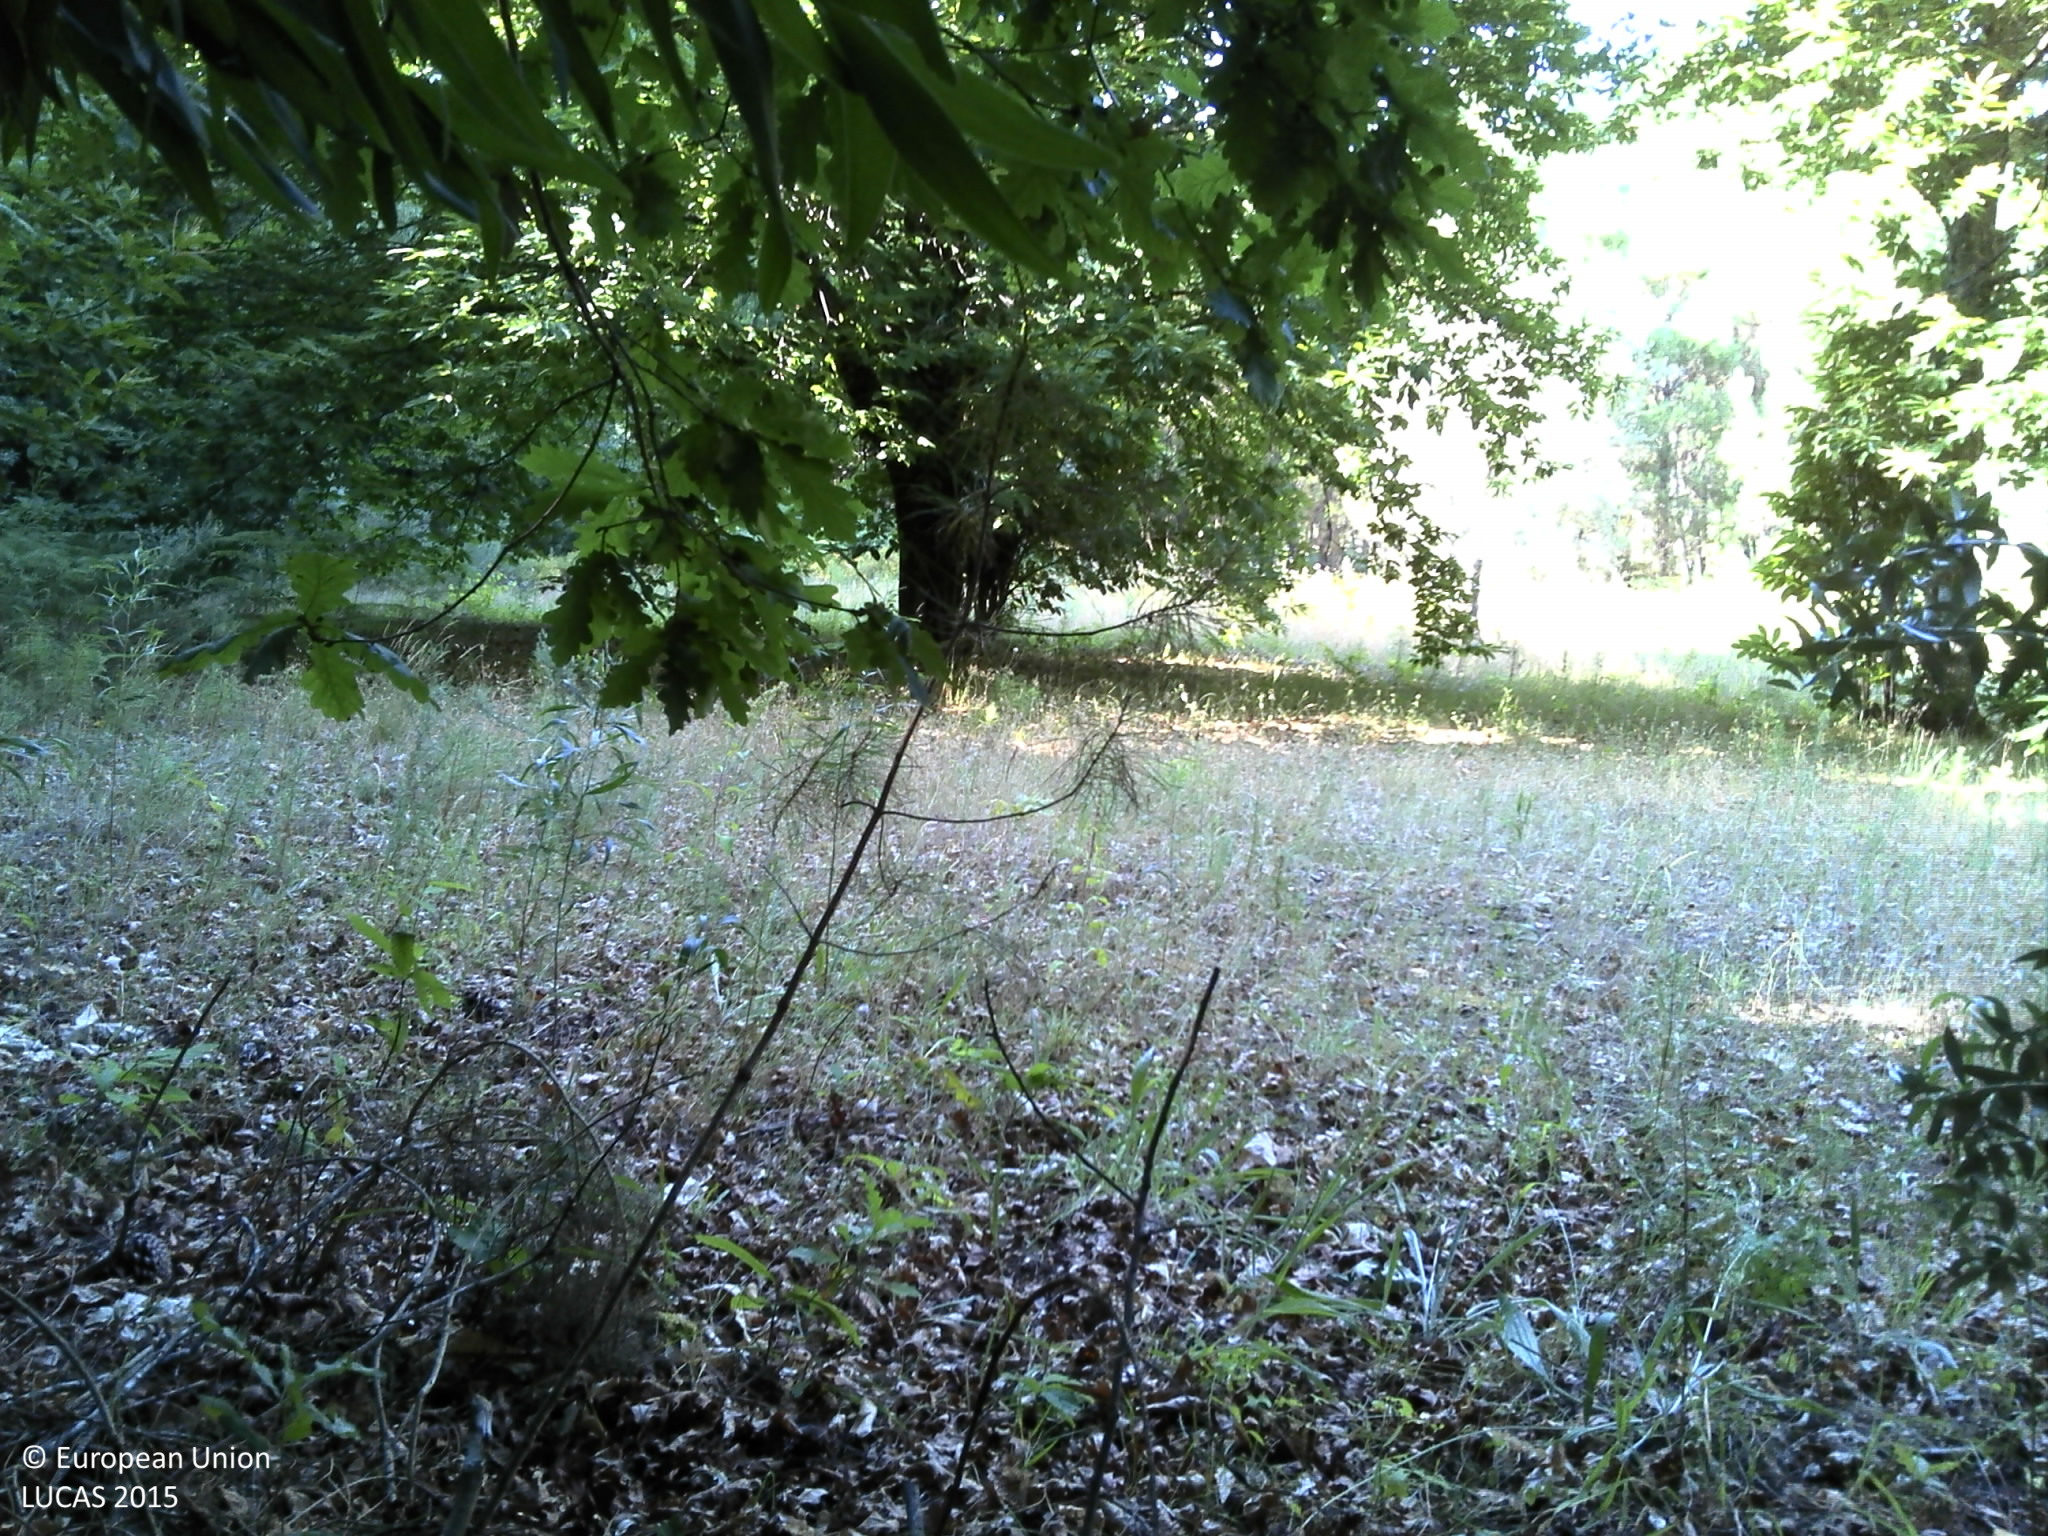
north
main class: Woodland
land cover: Broadleaved woodland
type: thermophilous deciduous forest
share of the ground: 10 - 25 %
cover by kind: broadleaved forest trees 75 %, unconsolidated bare surface 20 %, shrubs 5 %
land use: Forestry
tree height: > 5 m
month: July
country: PT
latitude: 40.7125
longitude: -7.7951
